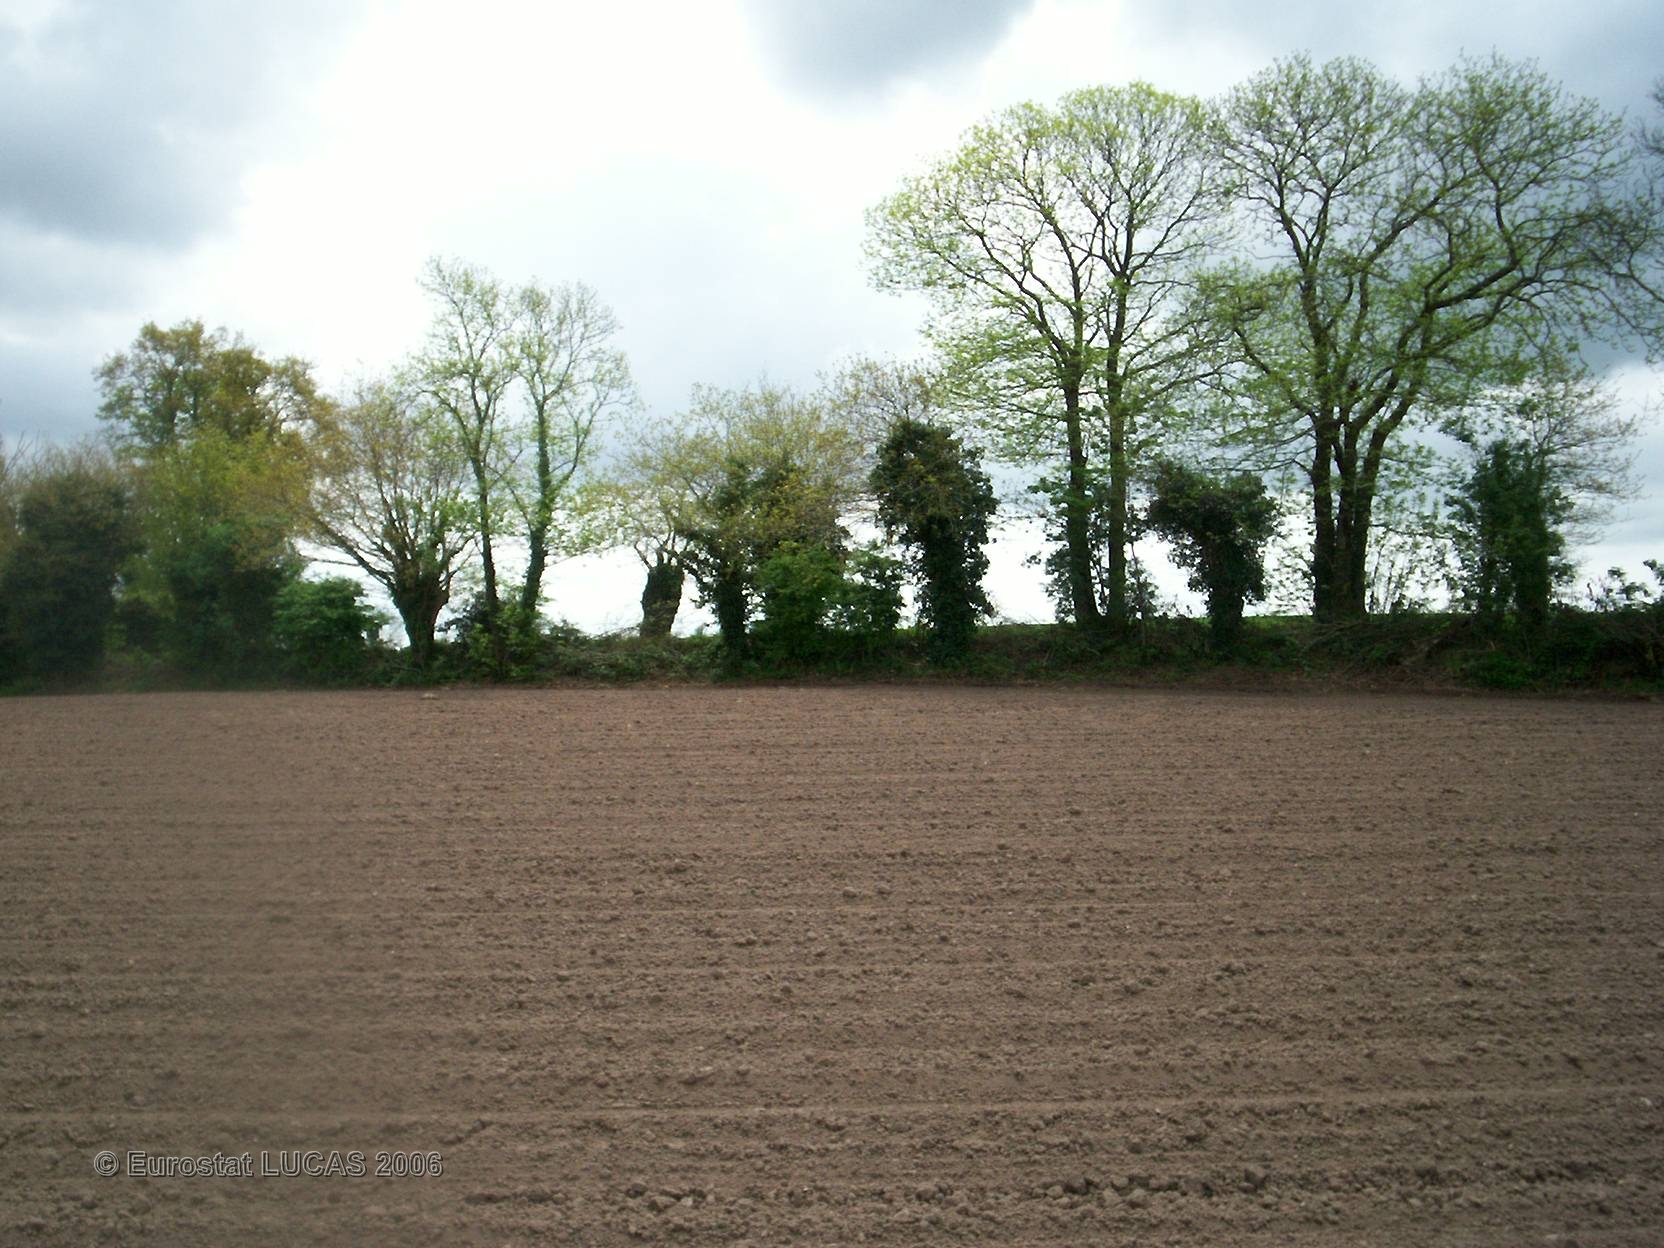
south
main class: Cropland
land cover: Maize
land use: Agriculture (excluding fallow land and kitchen gardens)
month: May
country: FR
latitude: 47.7230
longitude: -2.8487
